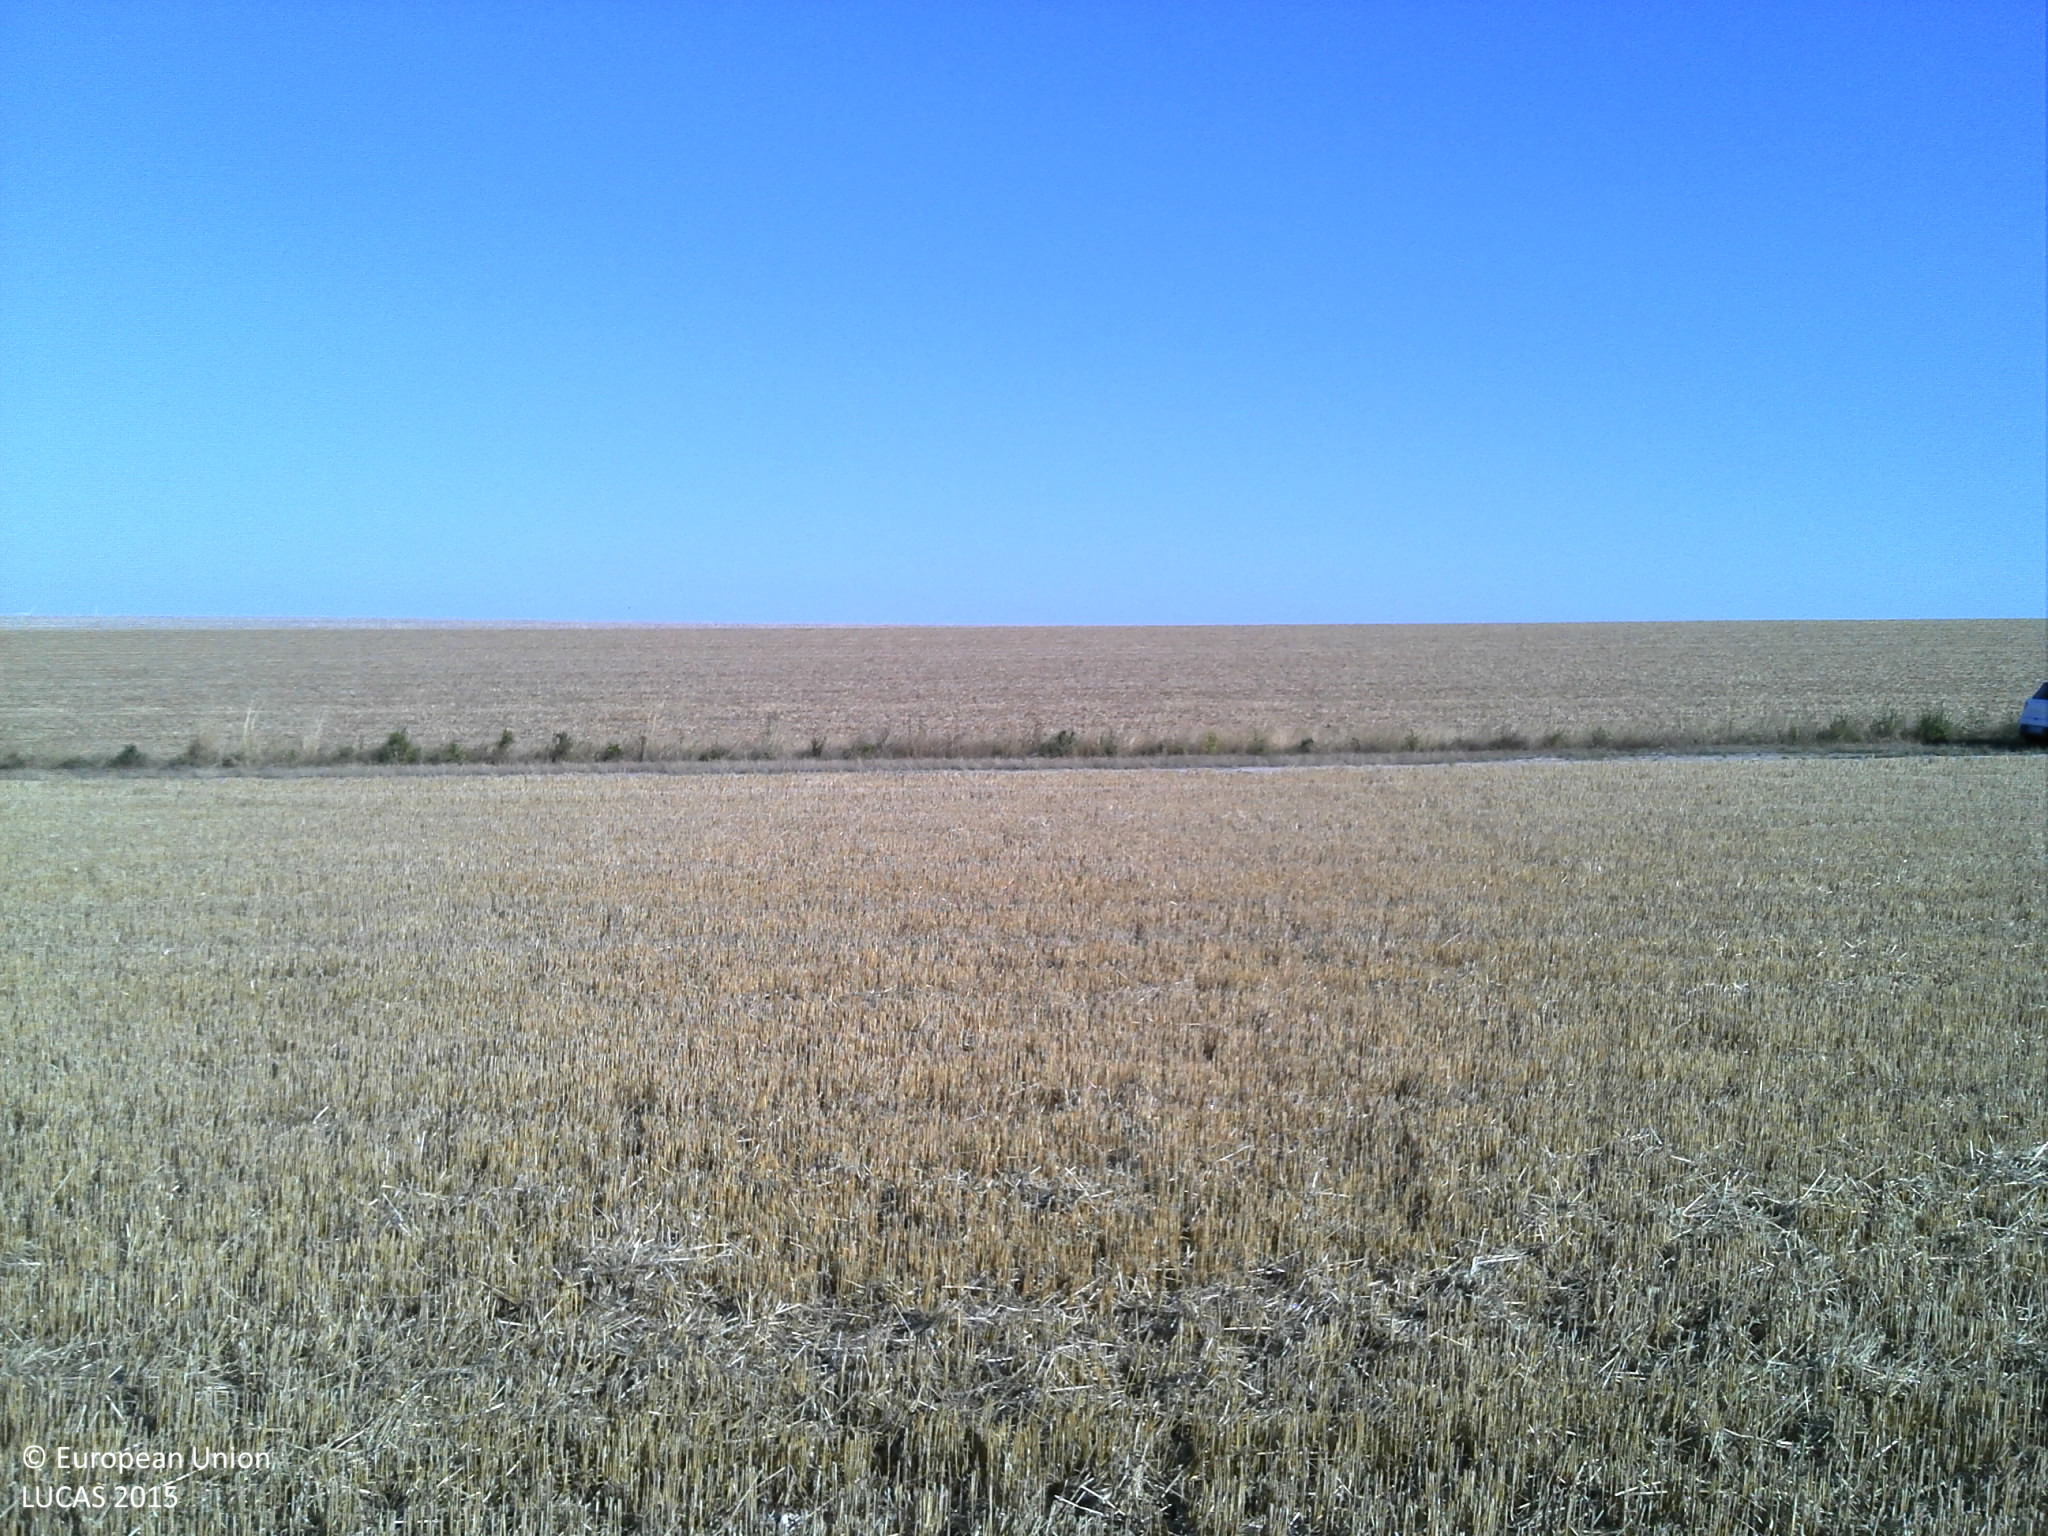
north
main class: Cropland
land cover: Barley
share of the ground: > 75 %
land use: Agriculture (excluding fallow land and kitchen gardens)
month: August
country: FR
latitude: 48.6151
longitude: 4.2586
